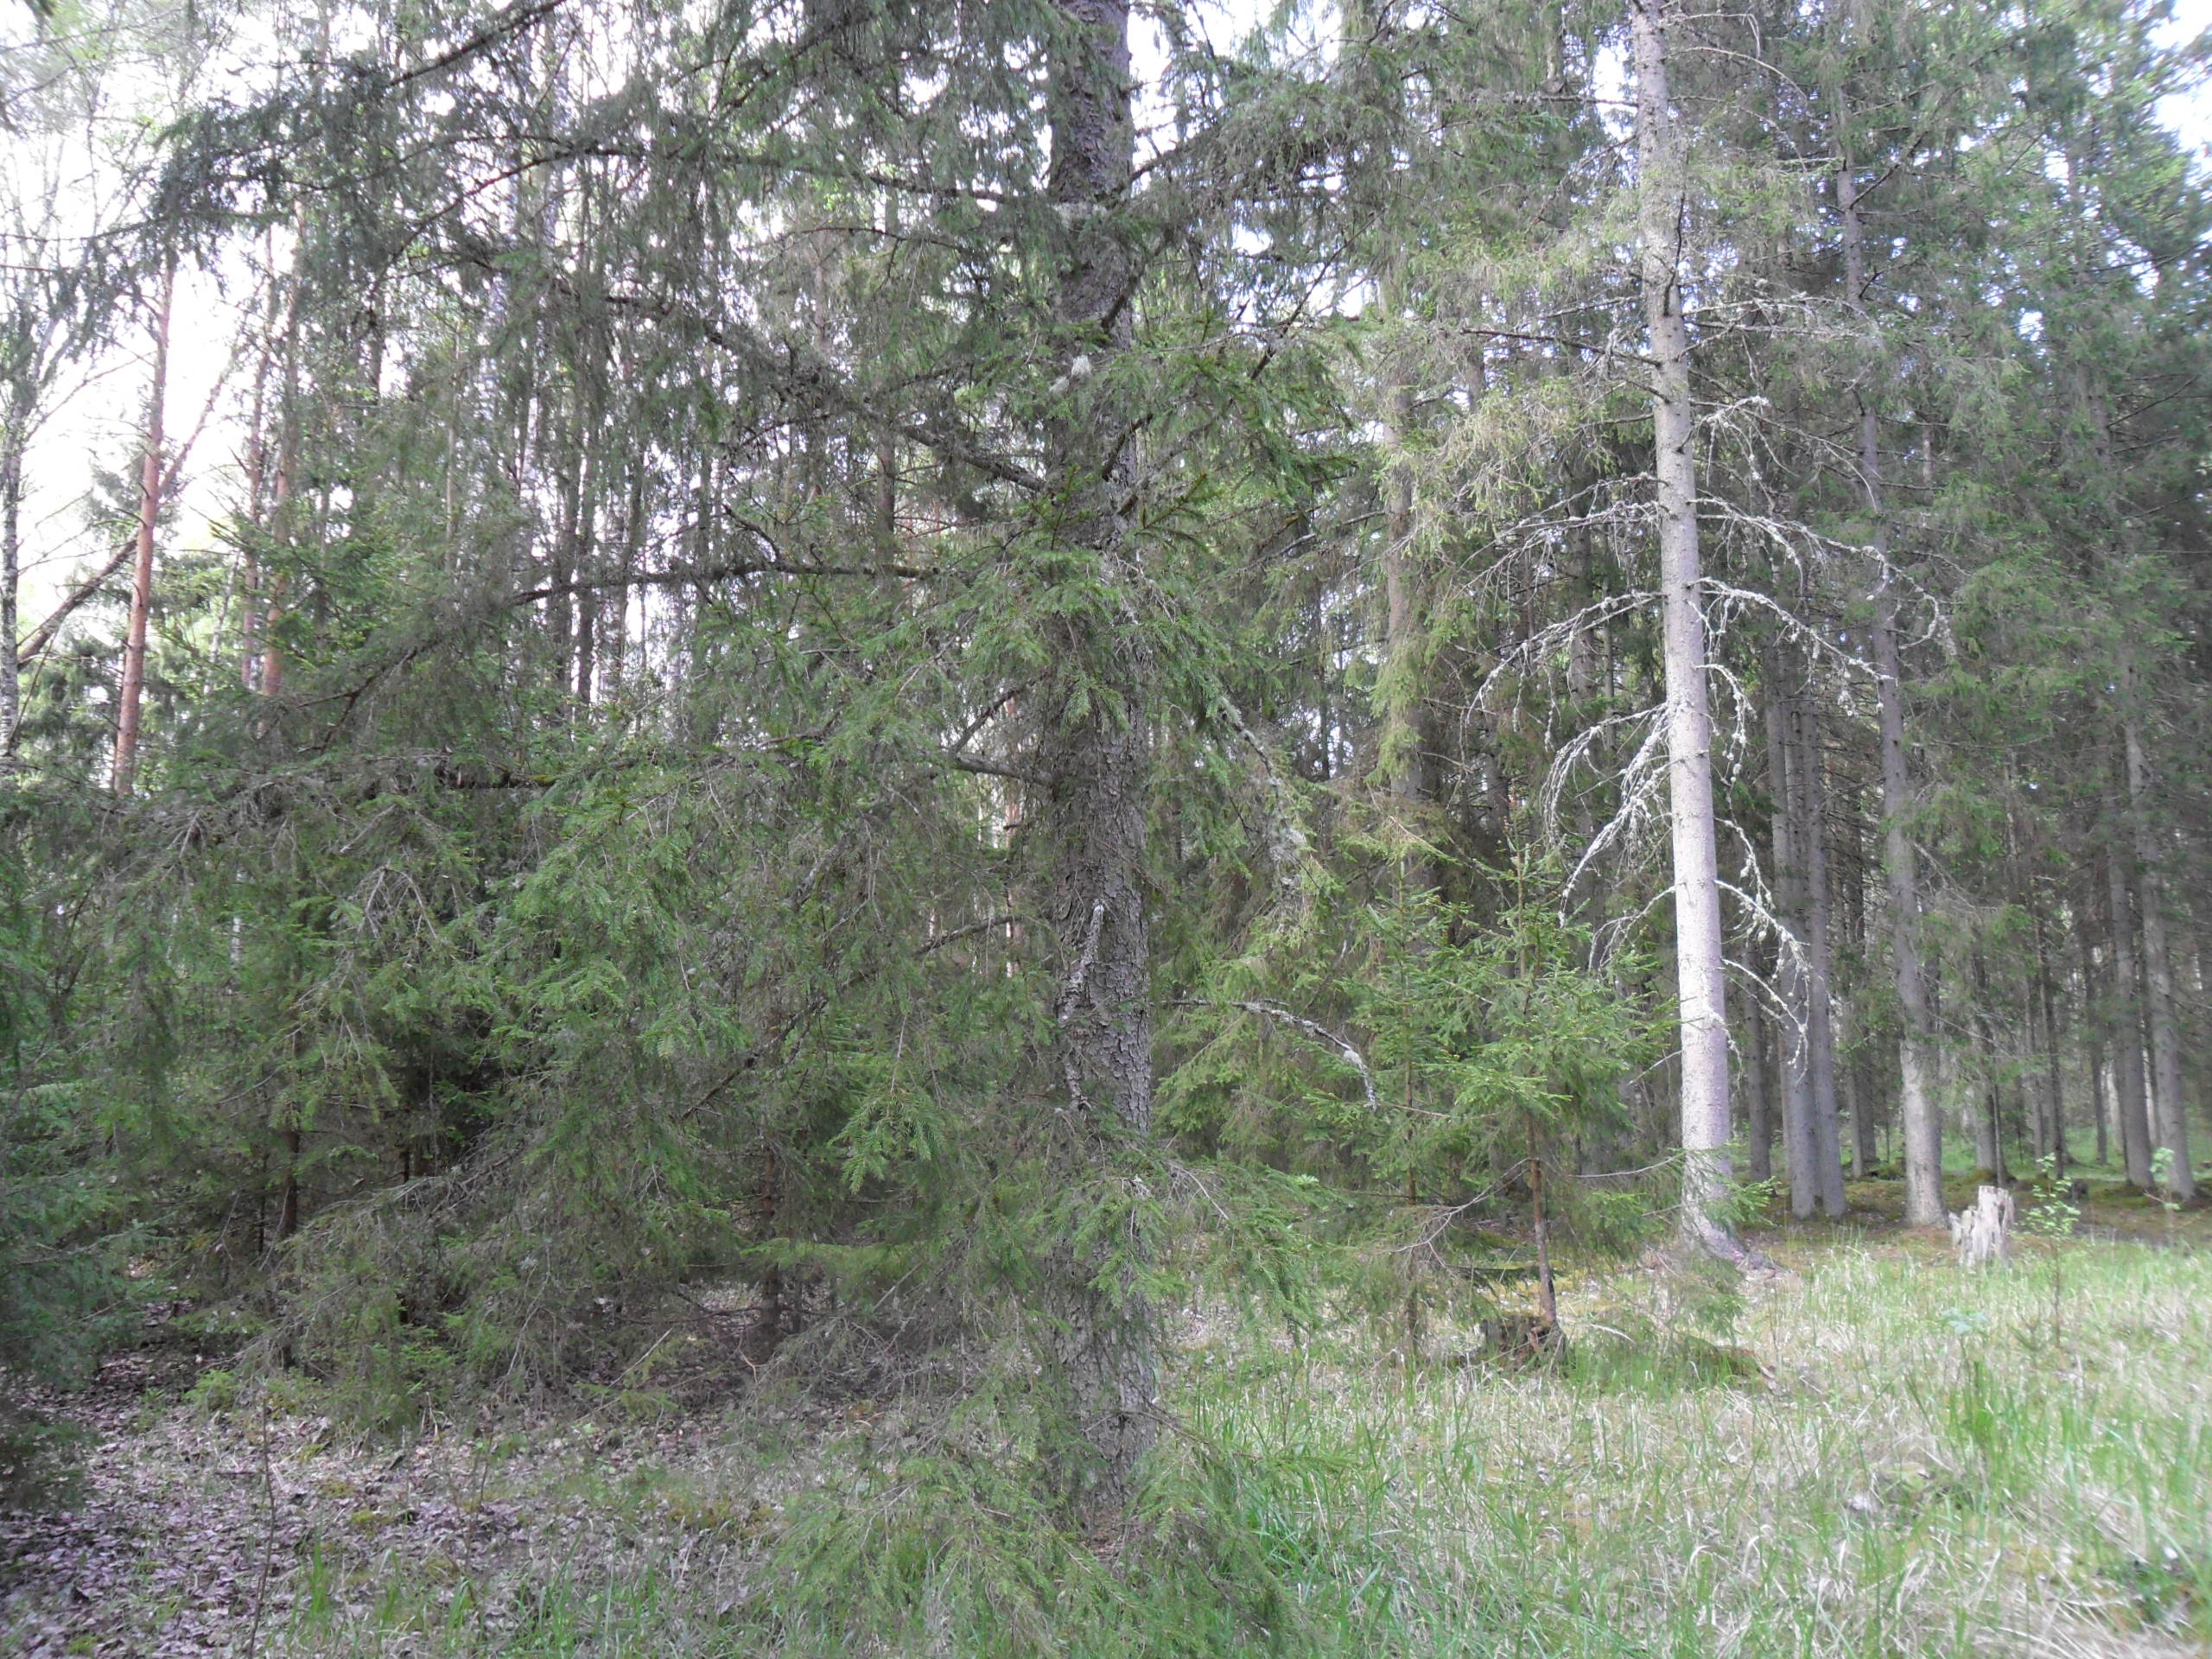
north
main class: Woodland
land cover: Spruce dominated mixed woodland
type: hemiboreal forest and nemoral coniferous forest and mixed broadleaved-coniferous forest
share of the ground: > 75 %
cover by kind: coniferous forest trees 55 %, broadleaved forest trees 45 %
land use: Forestry
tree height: > 5 m
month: May
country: LV
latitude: 57.2519
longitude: 23.0413
